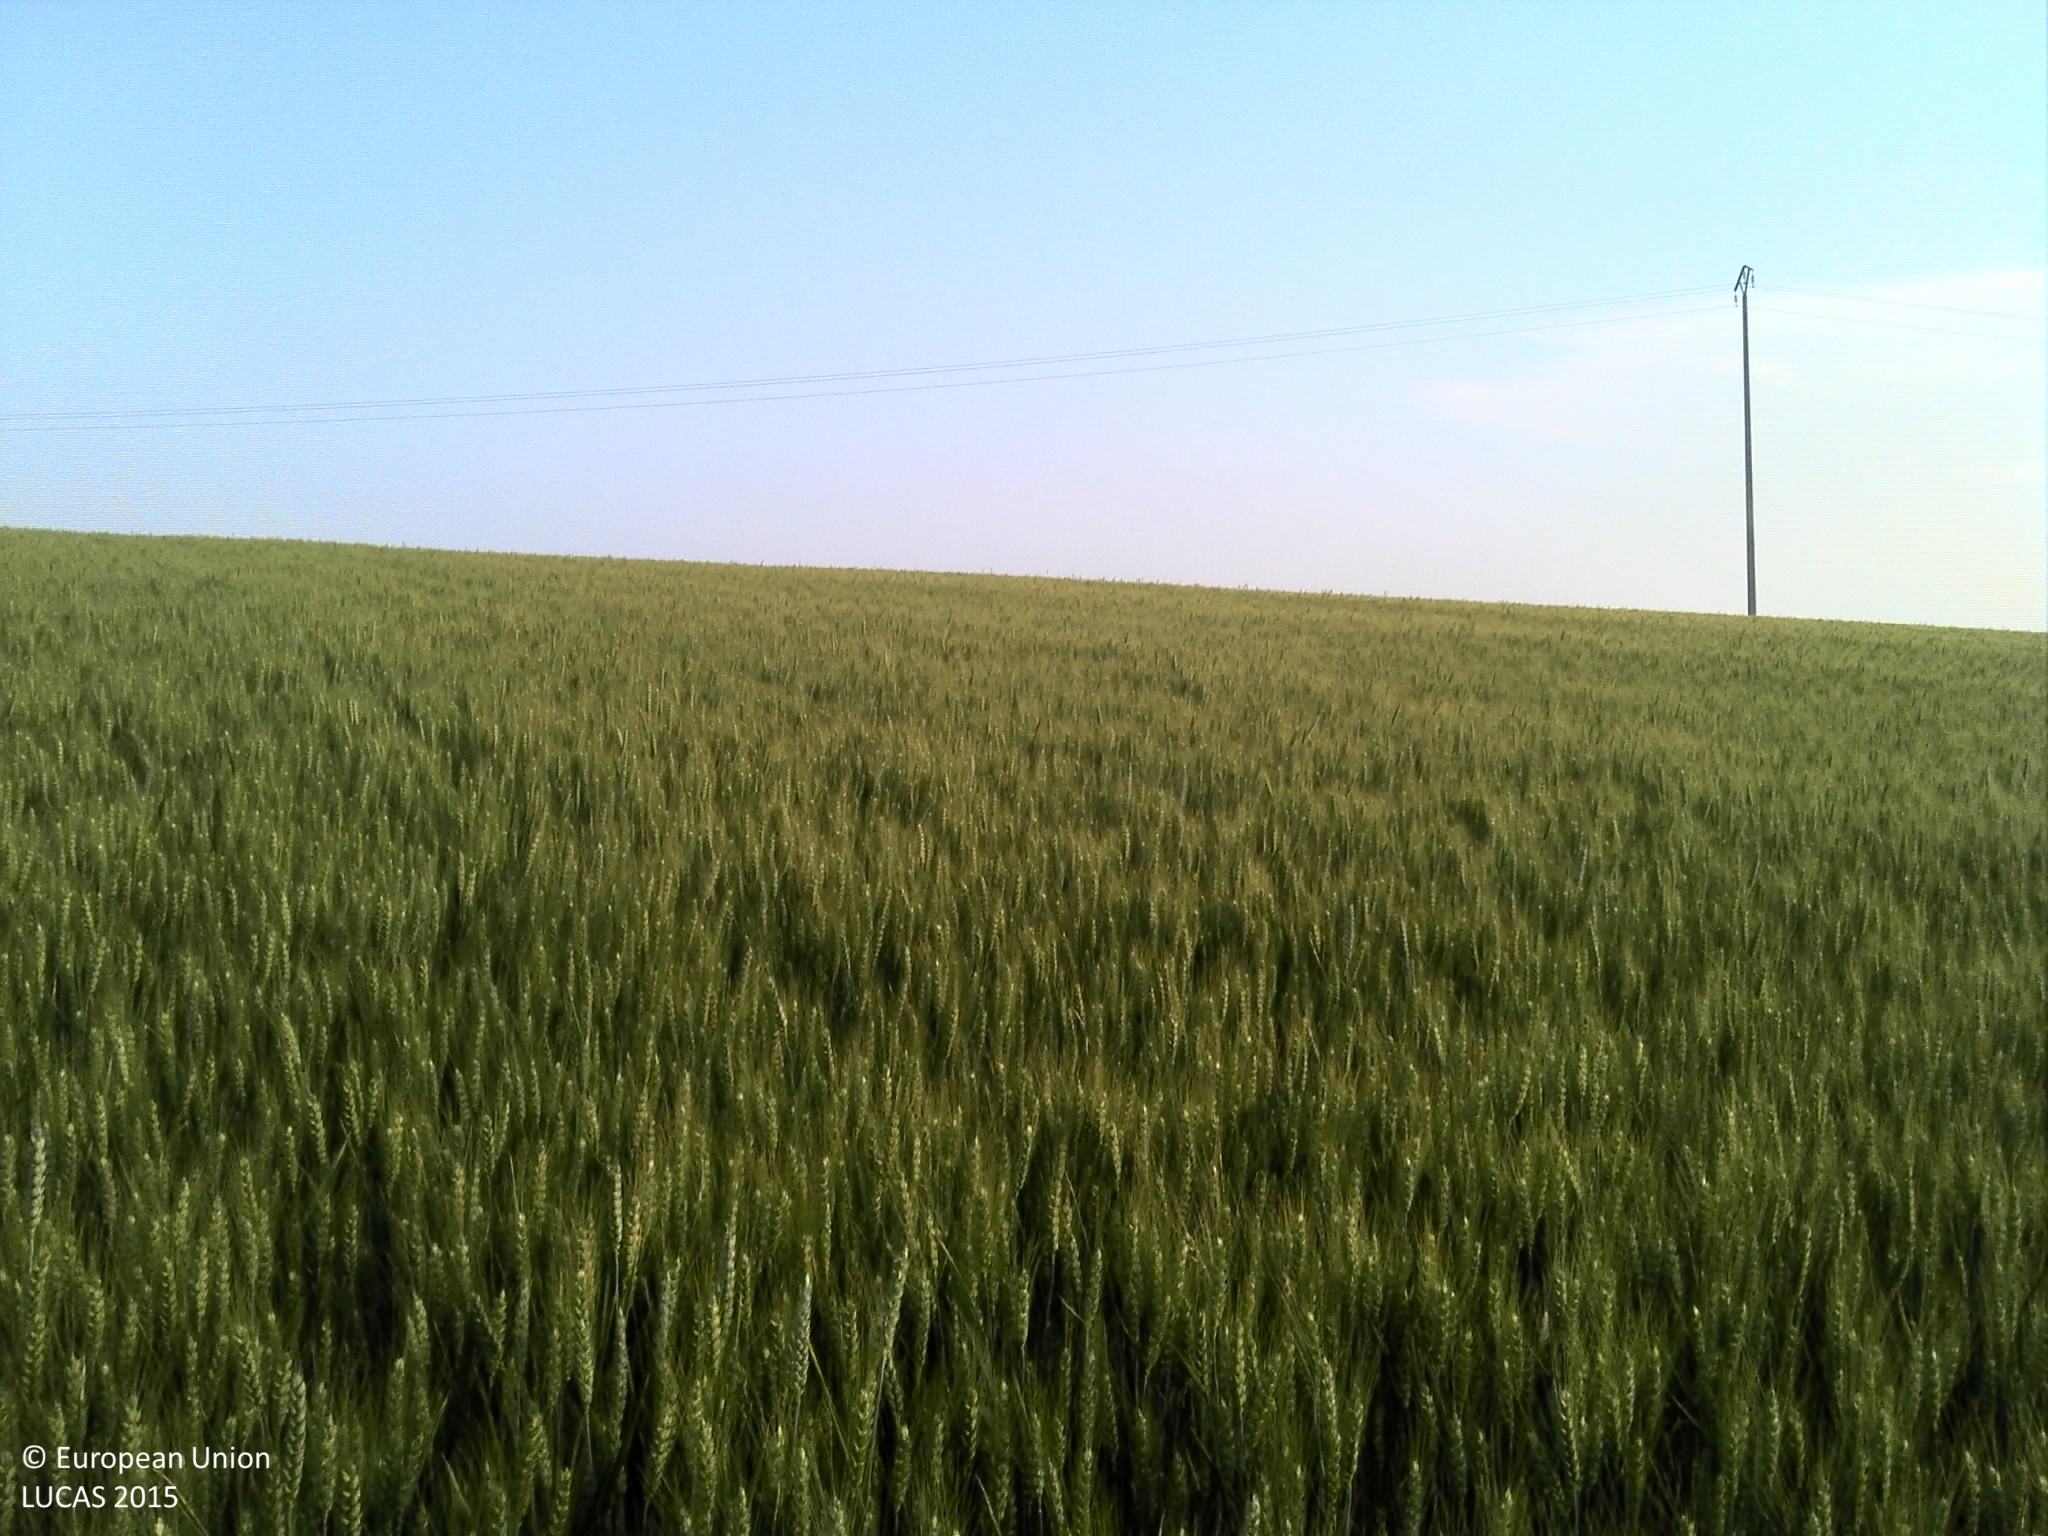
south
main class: Cropland
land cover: Common wheat
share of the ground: > 75 %
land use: Agriculture (excluding fallow land and kitchen gardens)
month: June
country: FR
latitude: 49.1326
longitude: 6.2582
